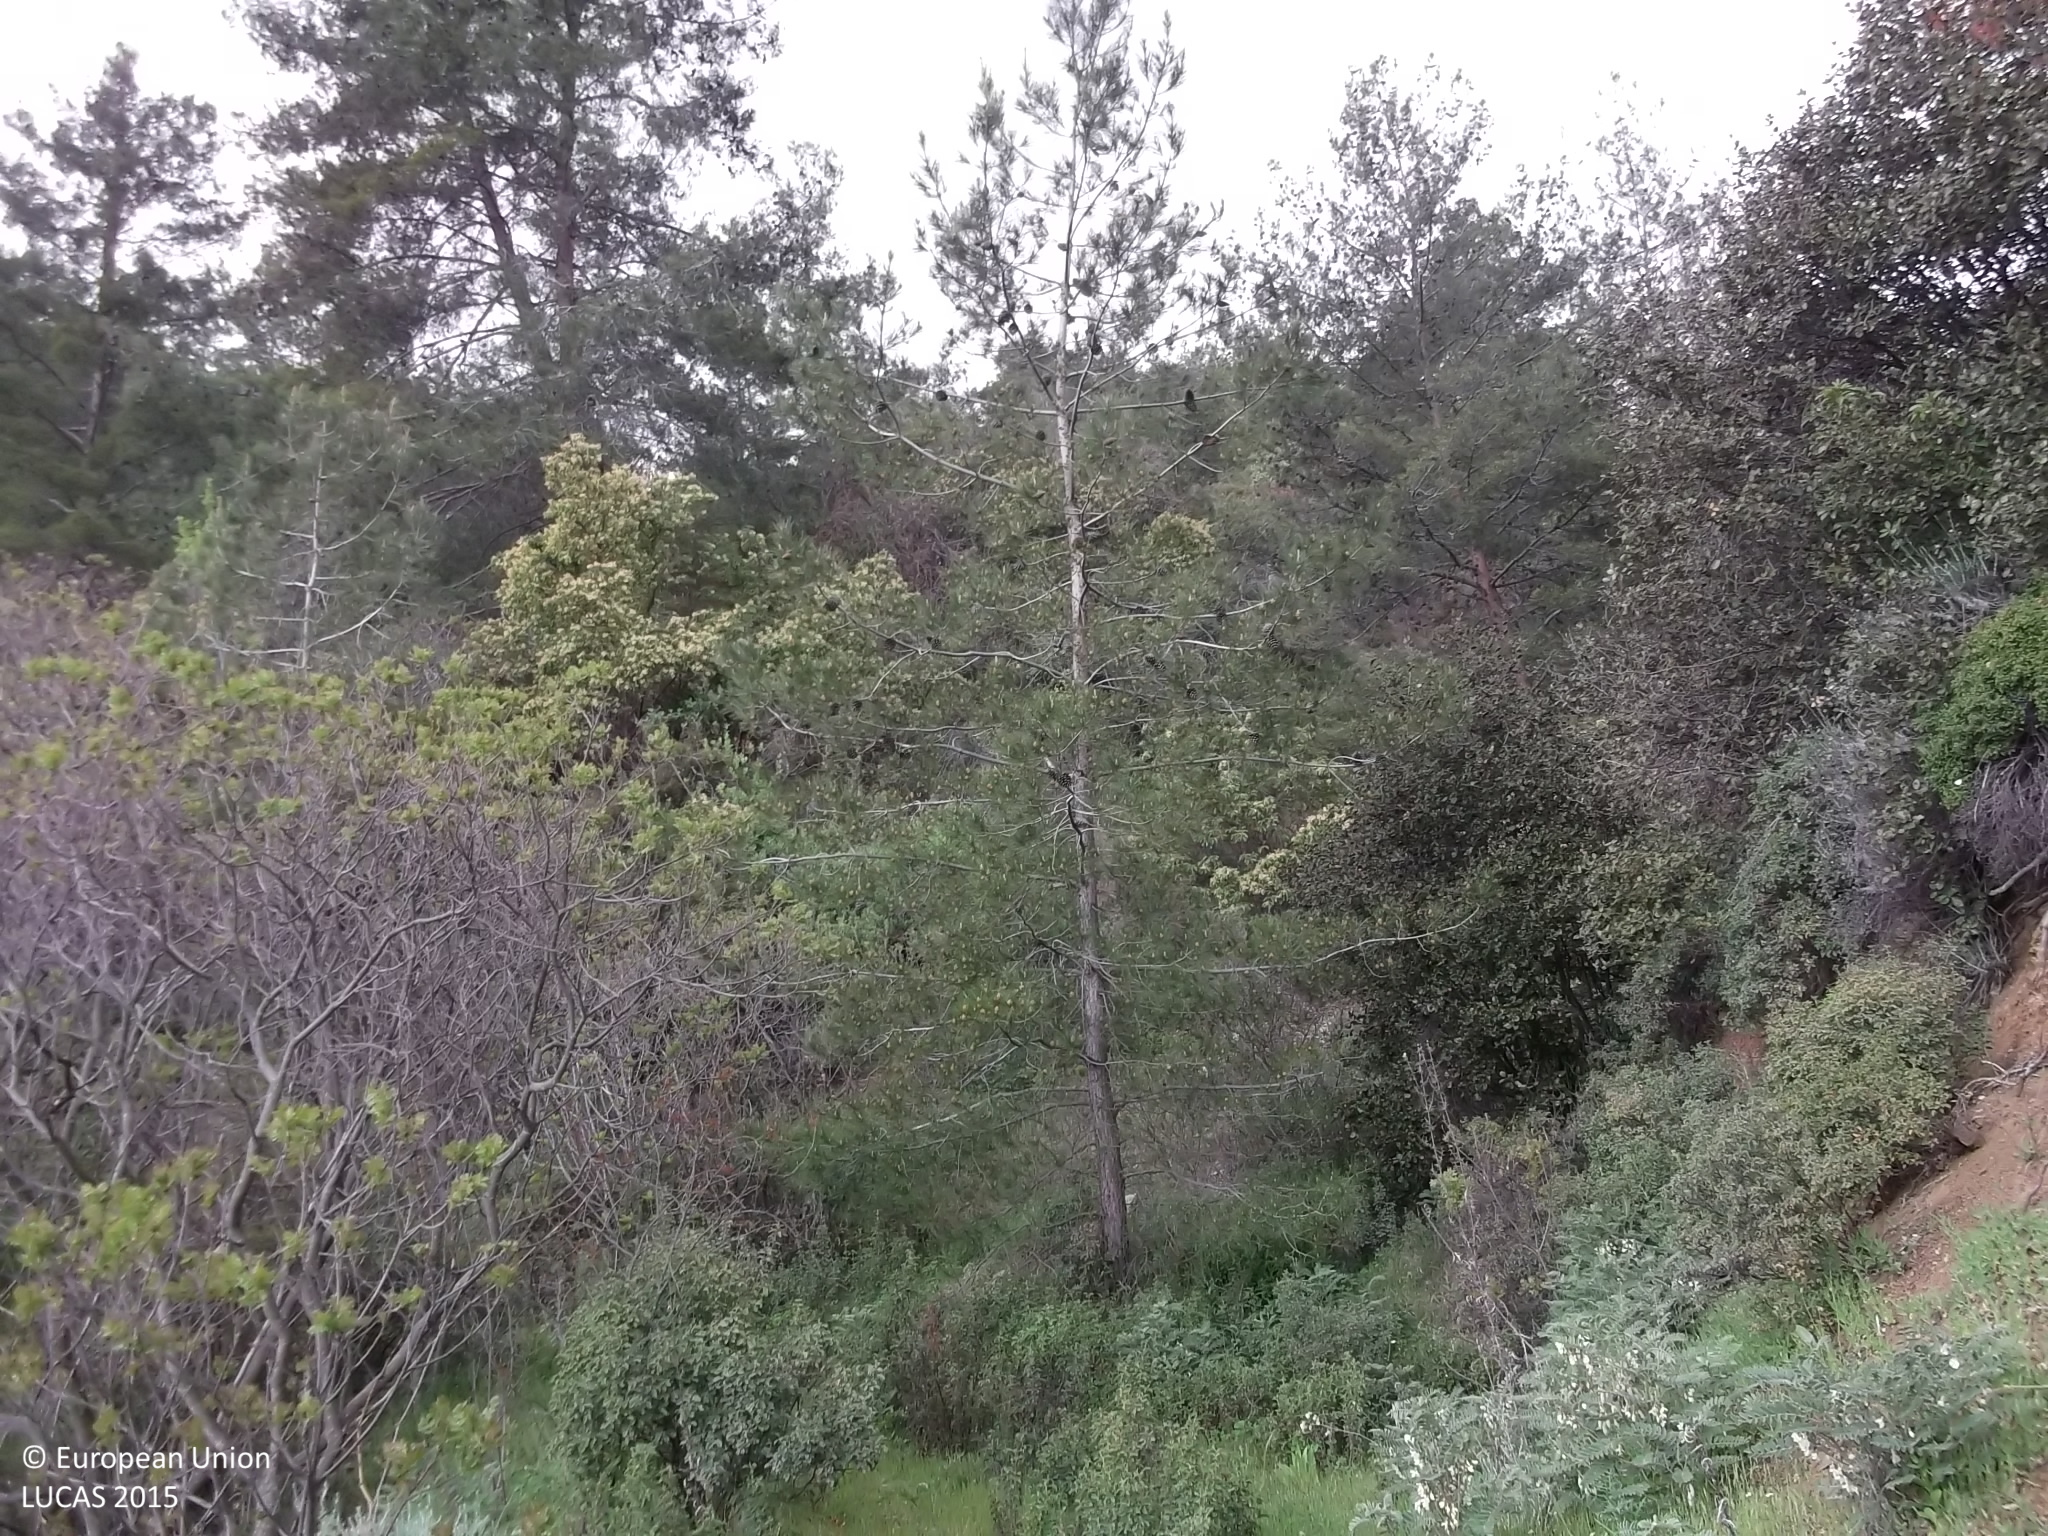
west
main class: Woodland
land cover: Pine dominated coniferous woodland
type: coniferous forest of the mediterranean region
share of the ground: > 75 %
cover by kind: coniferous forest trees 75 %, shrubs 20 %, unconsolidated bare surface 5 %
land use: Semi-natural and natural areas not in use
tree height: > 5 m
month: April
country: CY
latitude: 34.8875
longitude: 33.0742
